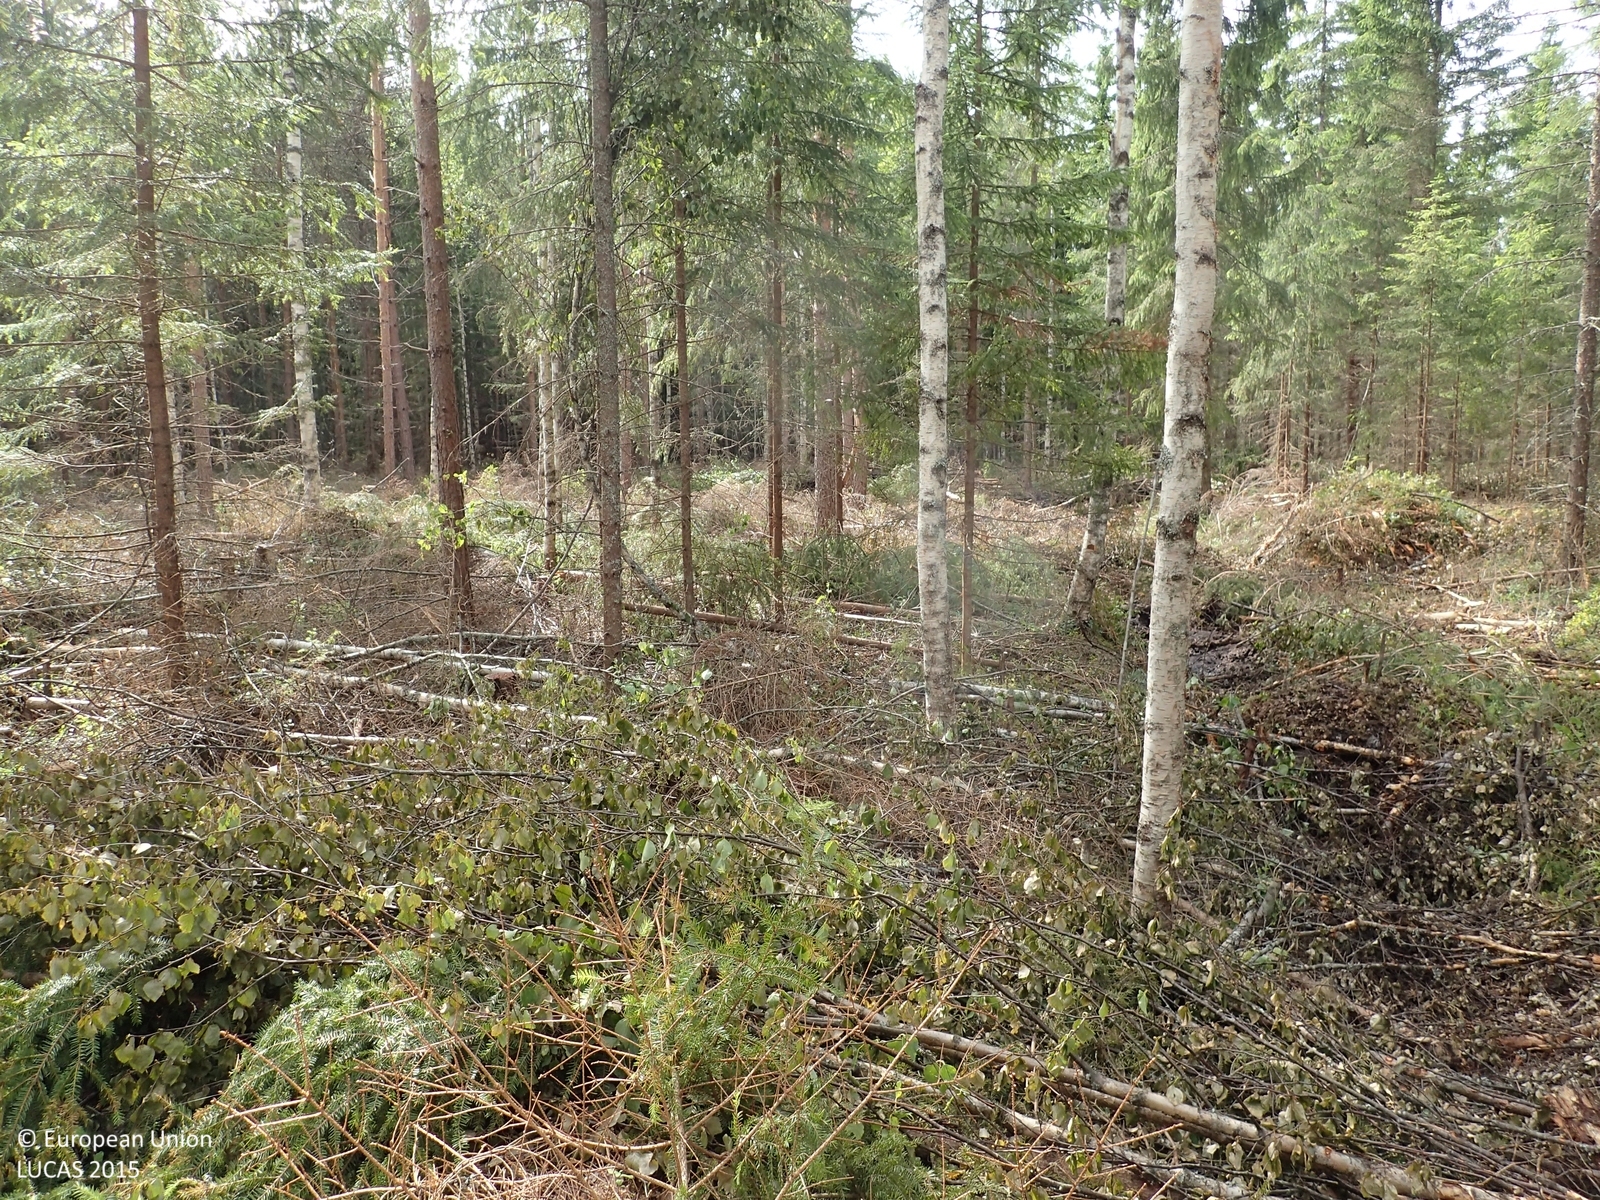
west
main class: Woodland
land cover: Spruce dominated coniferous woodland
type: boreal forest
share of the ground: 25 - 50 %
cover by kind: unconsolidated bare surface 50 %, coniferous forest trees 30 %, shrubs 15 %, broadleaved forest trees 5 %
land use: Forestry
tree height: > 5 m
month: July
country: FI
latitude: 62.9589
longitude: 21.4549
